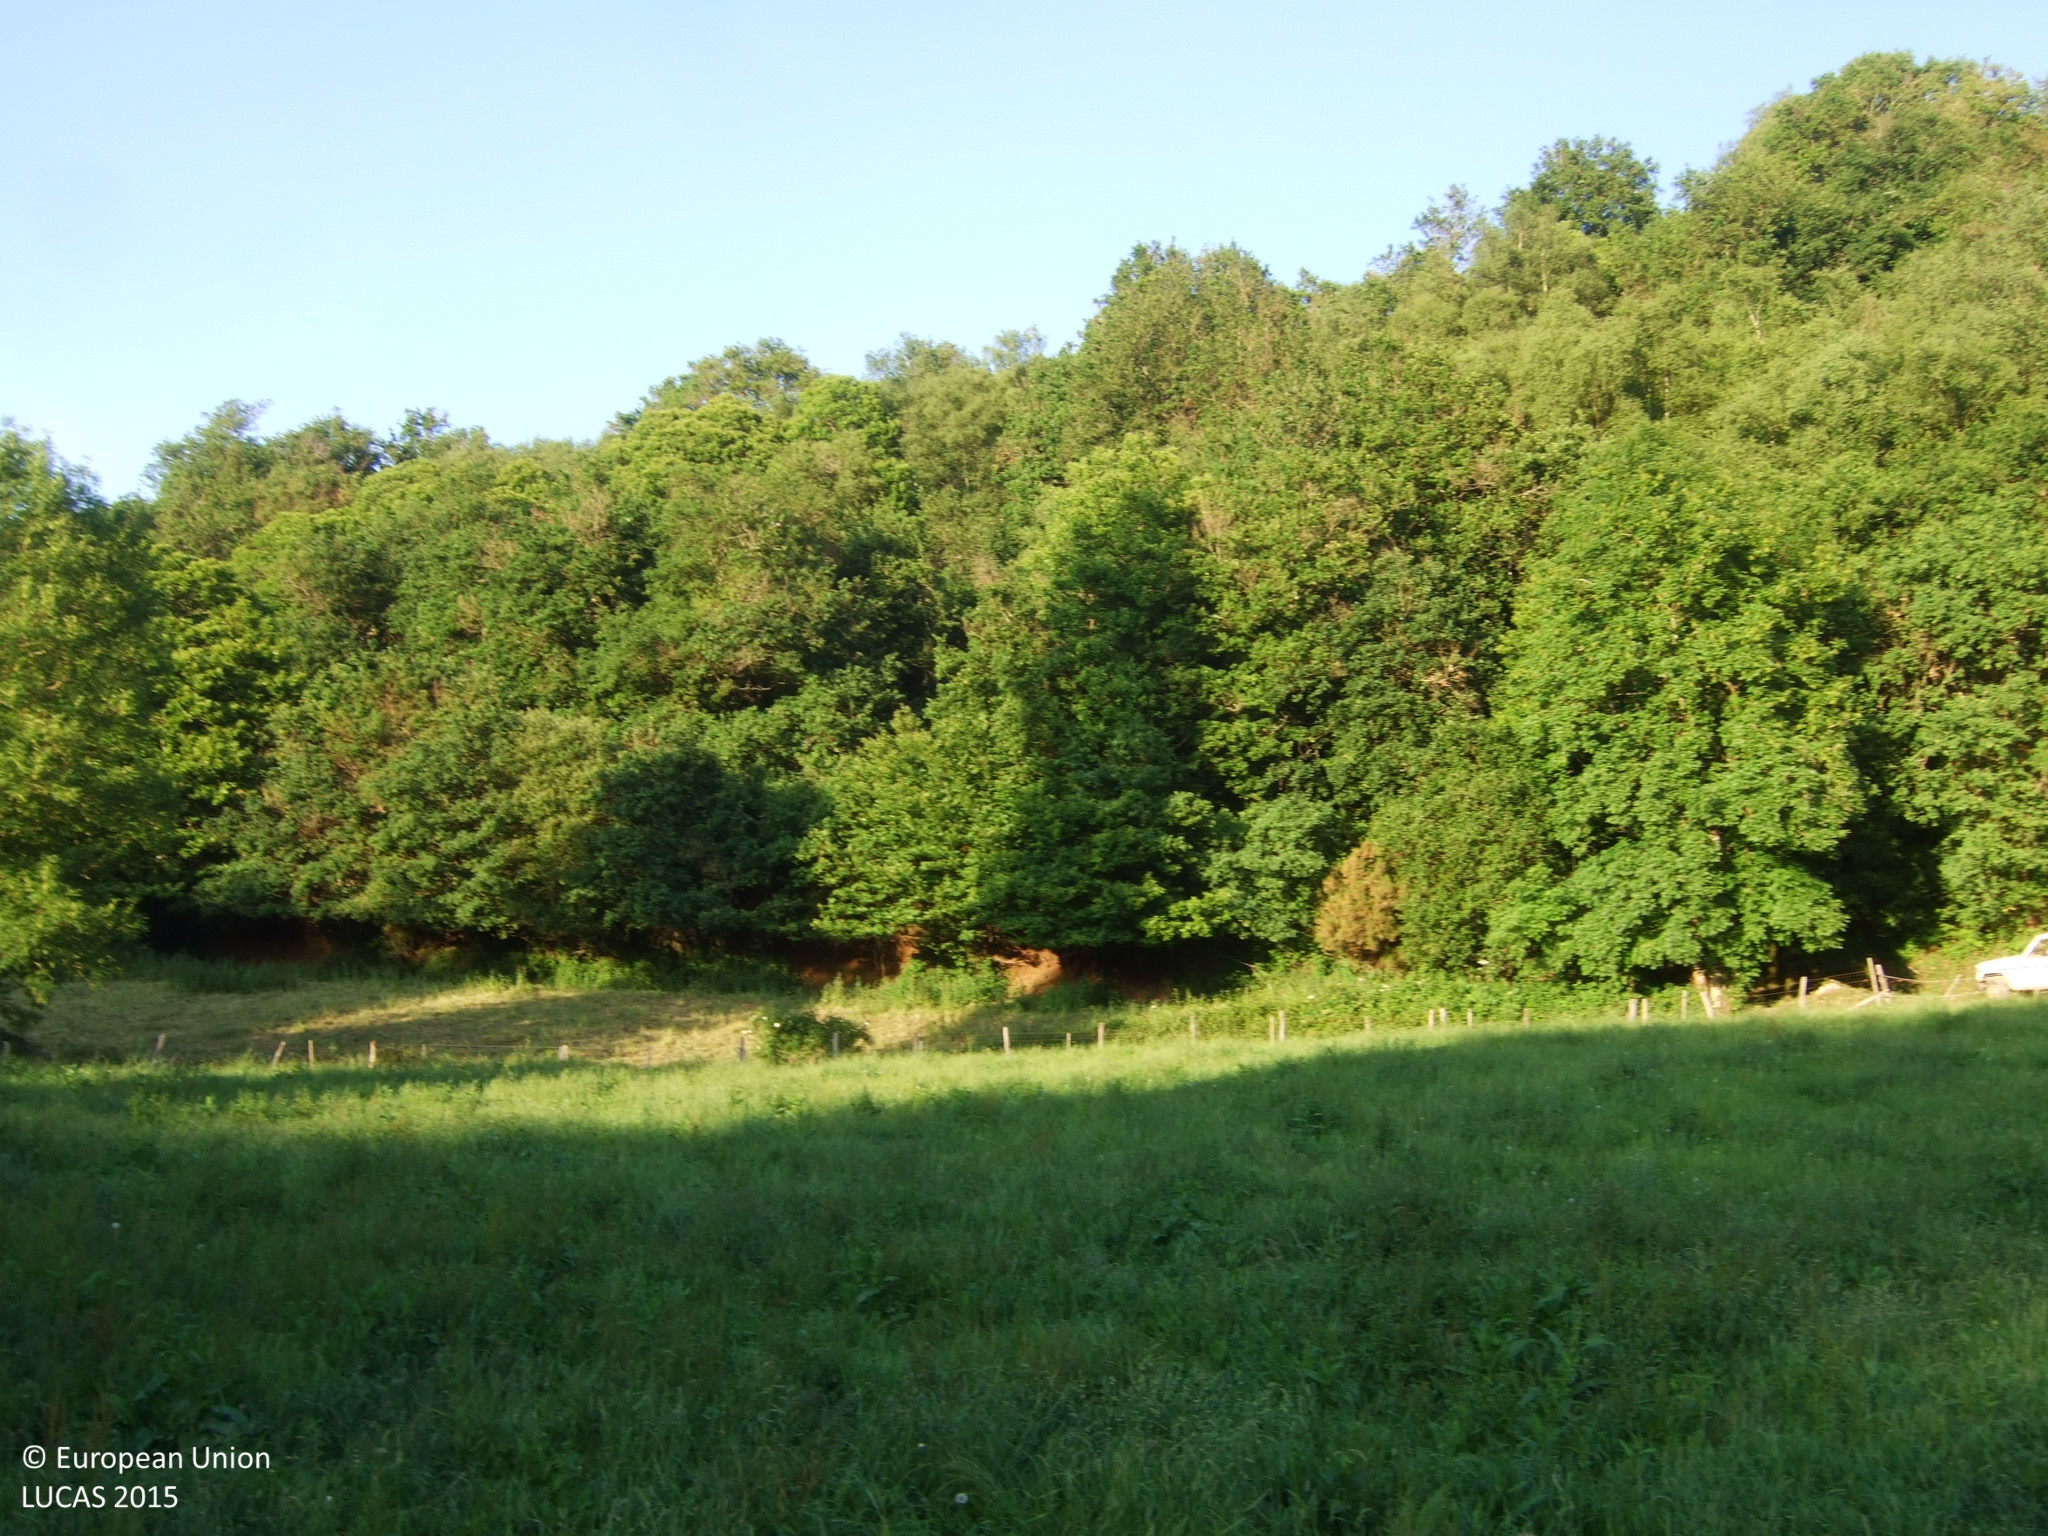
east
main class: Grassland
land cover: Grassland without tree/shrub cover
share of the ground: > 75 %
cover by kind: herbaceous plants 100 %
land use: Agriculture (excluding fallow land and kitchen gardens)
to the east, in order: Grassland without tree/shrub cover; Fences; Tracks; Shruby margins; Grassland without tree/shrub cover; Broadleaved woodland; Tracks; Broadleaved woodland; Paved roads, cycling and walking lanes; Broadleaved woodland; Tracks; Groves; Grassland without tree/shrub cover; Shruby margins; Grassland without tree/shrub cover
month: June
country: ES
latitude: 42.7713
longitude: -7.3121
